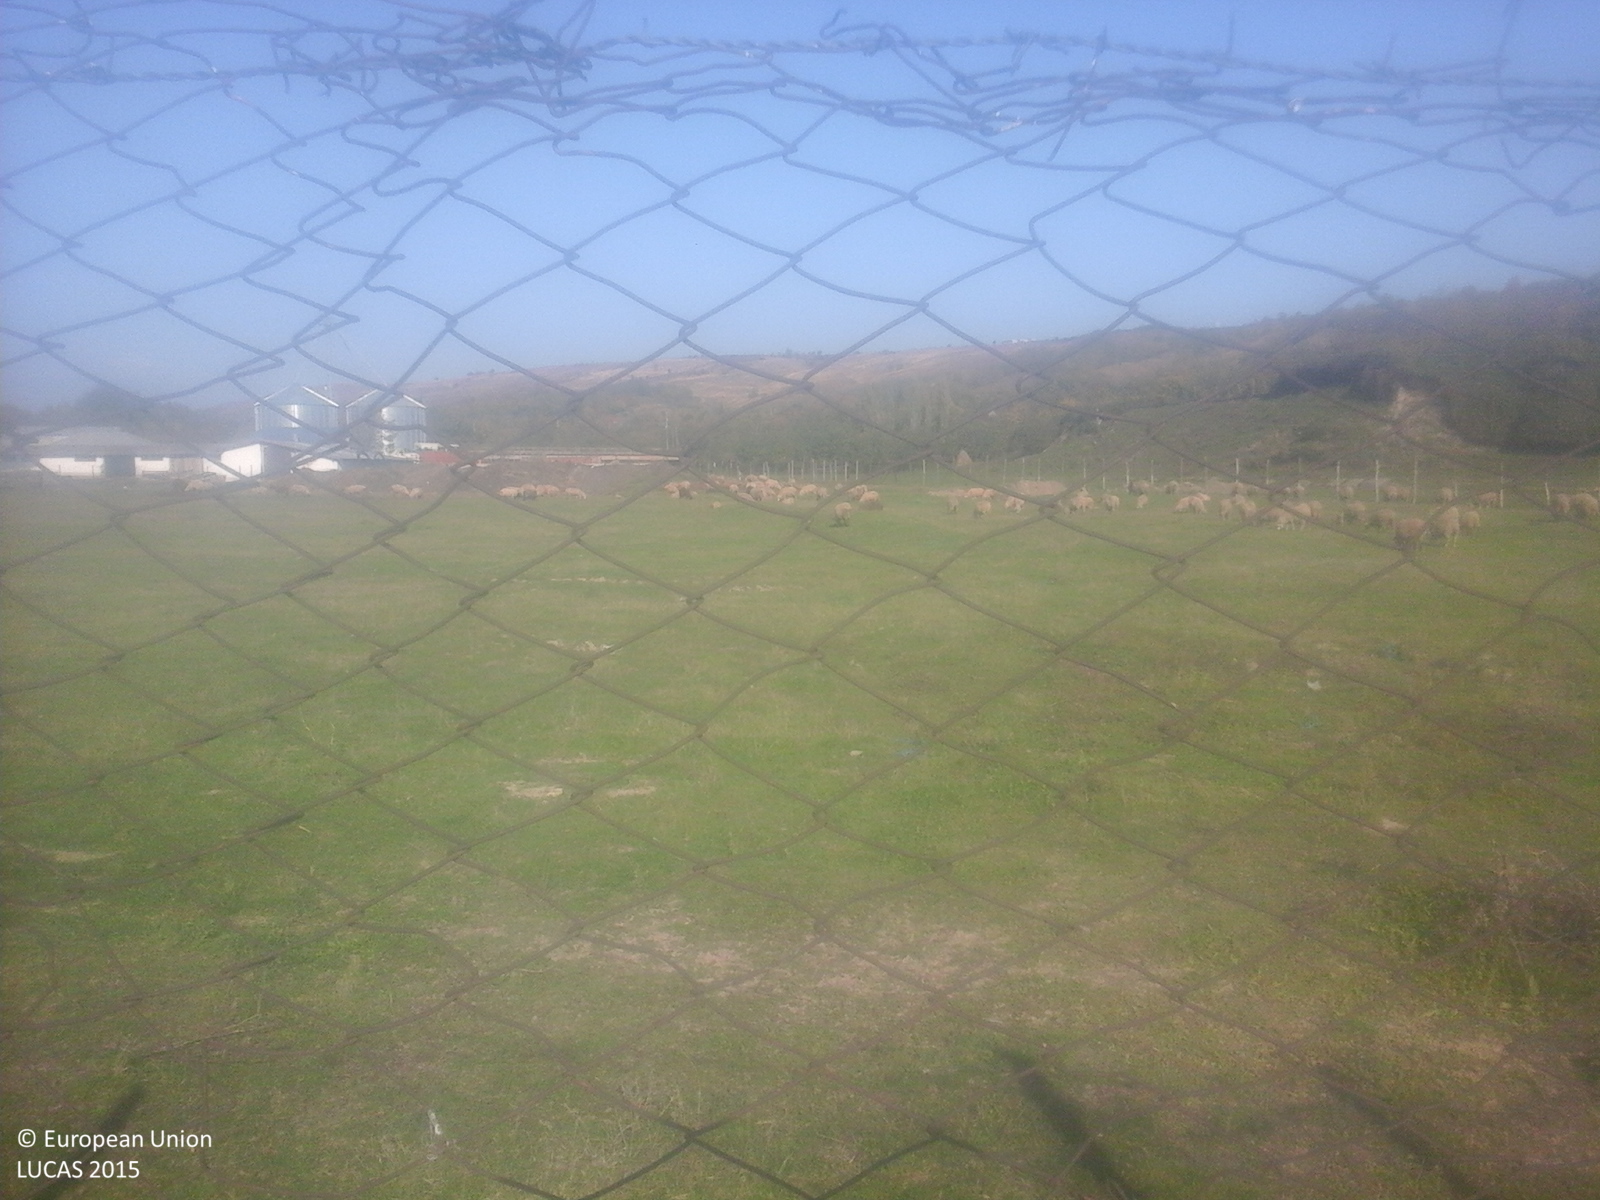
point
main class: Grassland
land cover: Grassland without tree/shrub cover
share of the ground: > 75 %
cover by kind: herbaceous plants 100 %
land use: Agriculture (excluding fallow land and kitchen gardens)
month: October
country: RO
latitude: 45.2921
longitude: 26.8754
